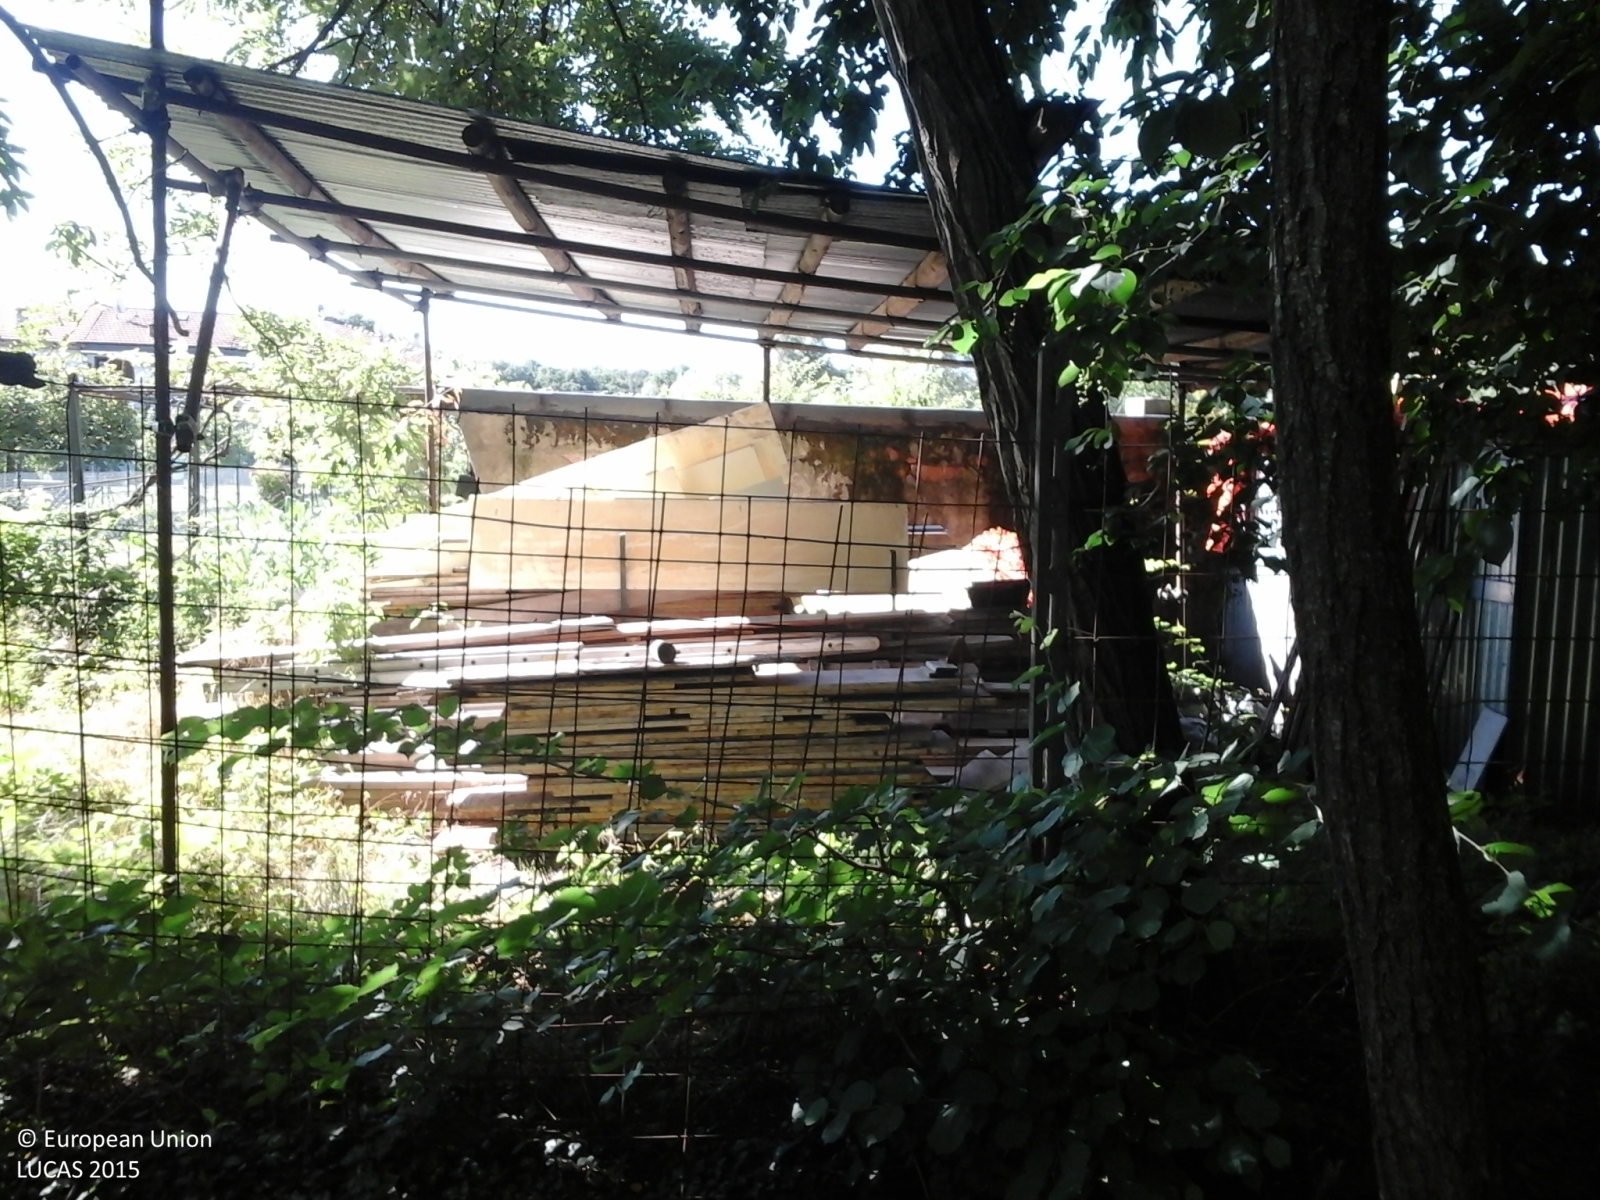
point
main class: Woodland
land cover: Broadleaved woodland
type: exotic forest
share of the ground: > 75 %
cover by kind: broadleaved forest trees 80 %, shrubs 10 %, herbaceous plants 10 %
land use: Forestry
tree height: < 5 m
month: June
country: IT
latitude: 45.7835
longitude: 8.6001
